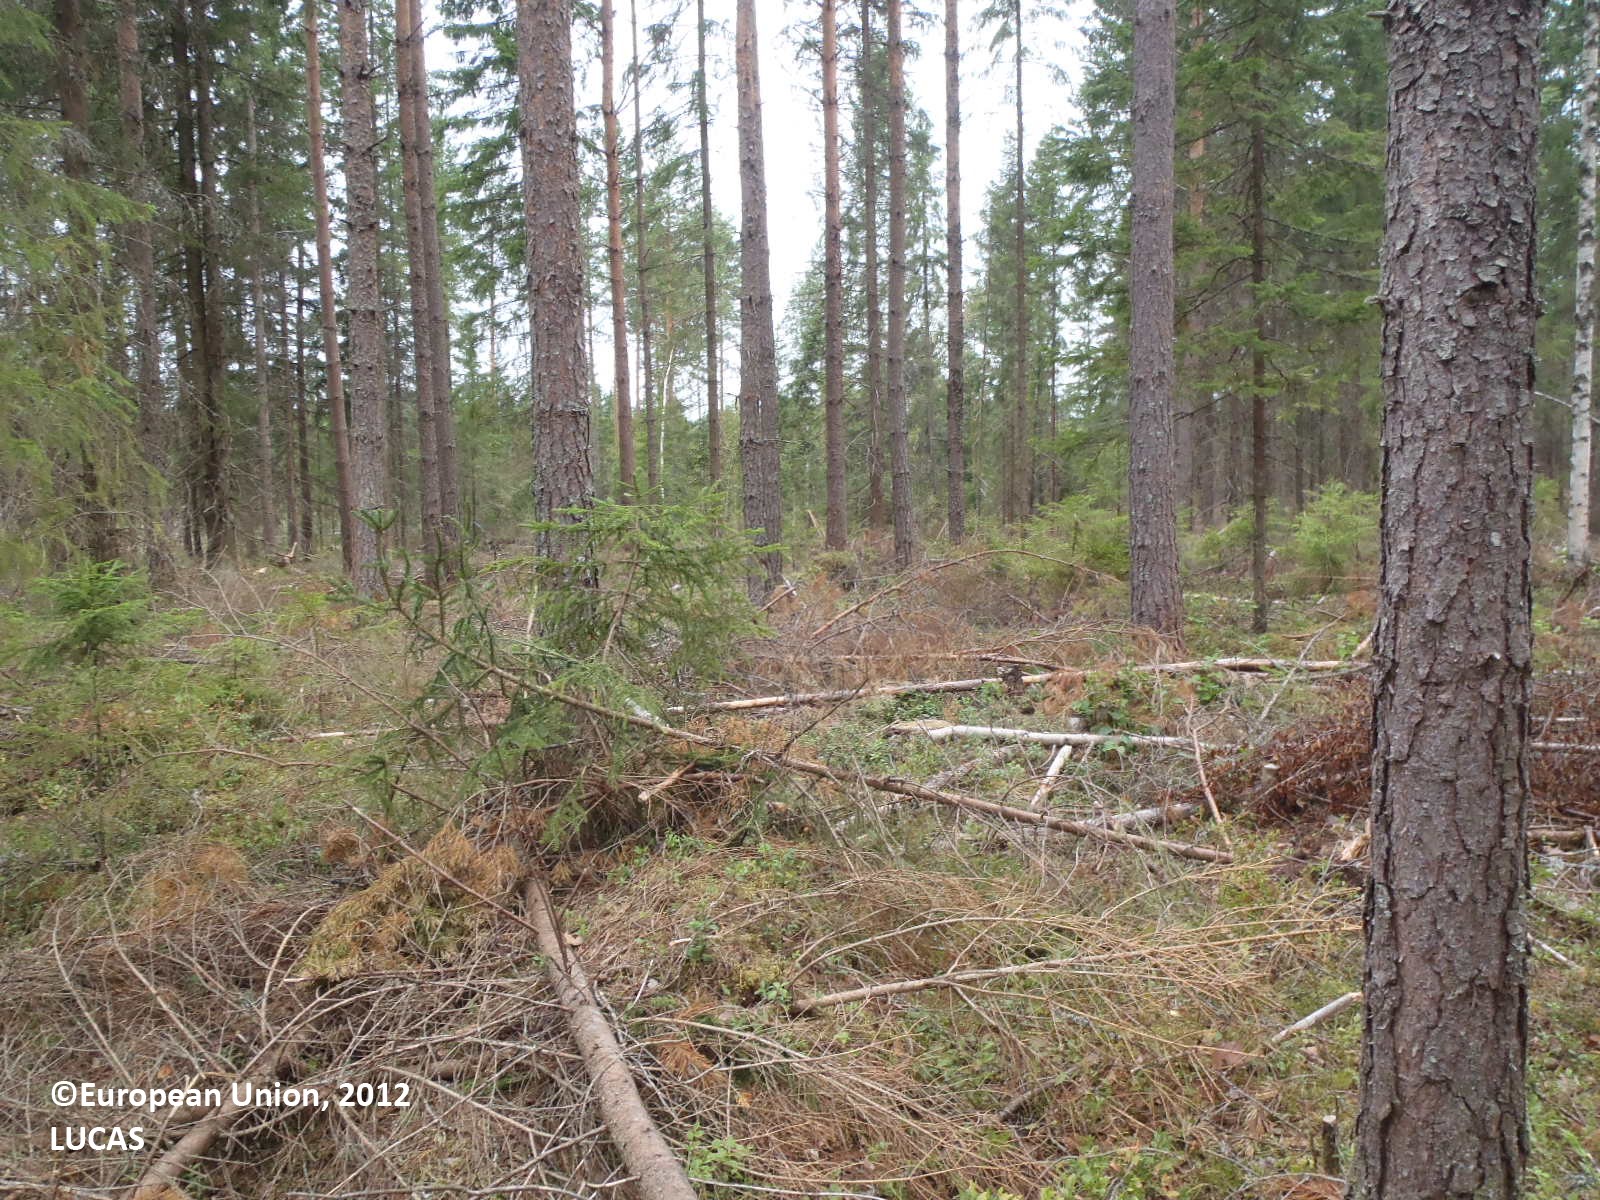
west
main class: Woodland
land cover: Pine dominated mixed woodland
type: boreal forest
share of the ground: > 75 %
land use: Forestry
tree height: > 5 m
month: August
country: FI
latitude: 60.8145
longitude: 22.4396
